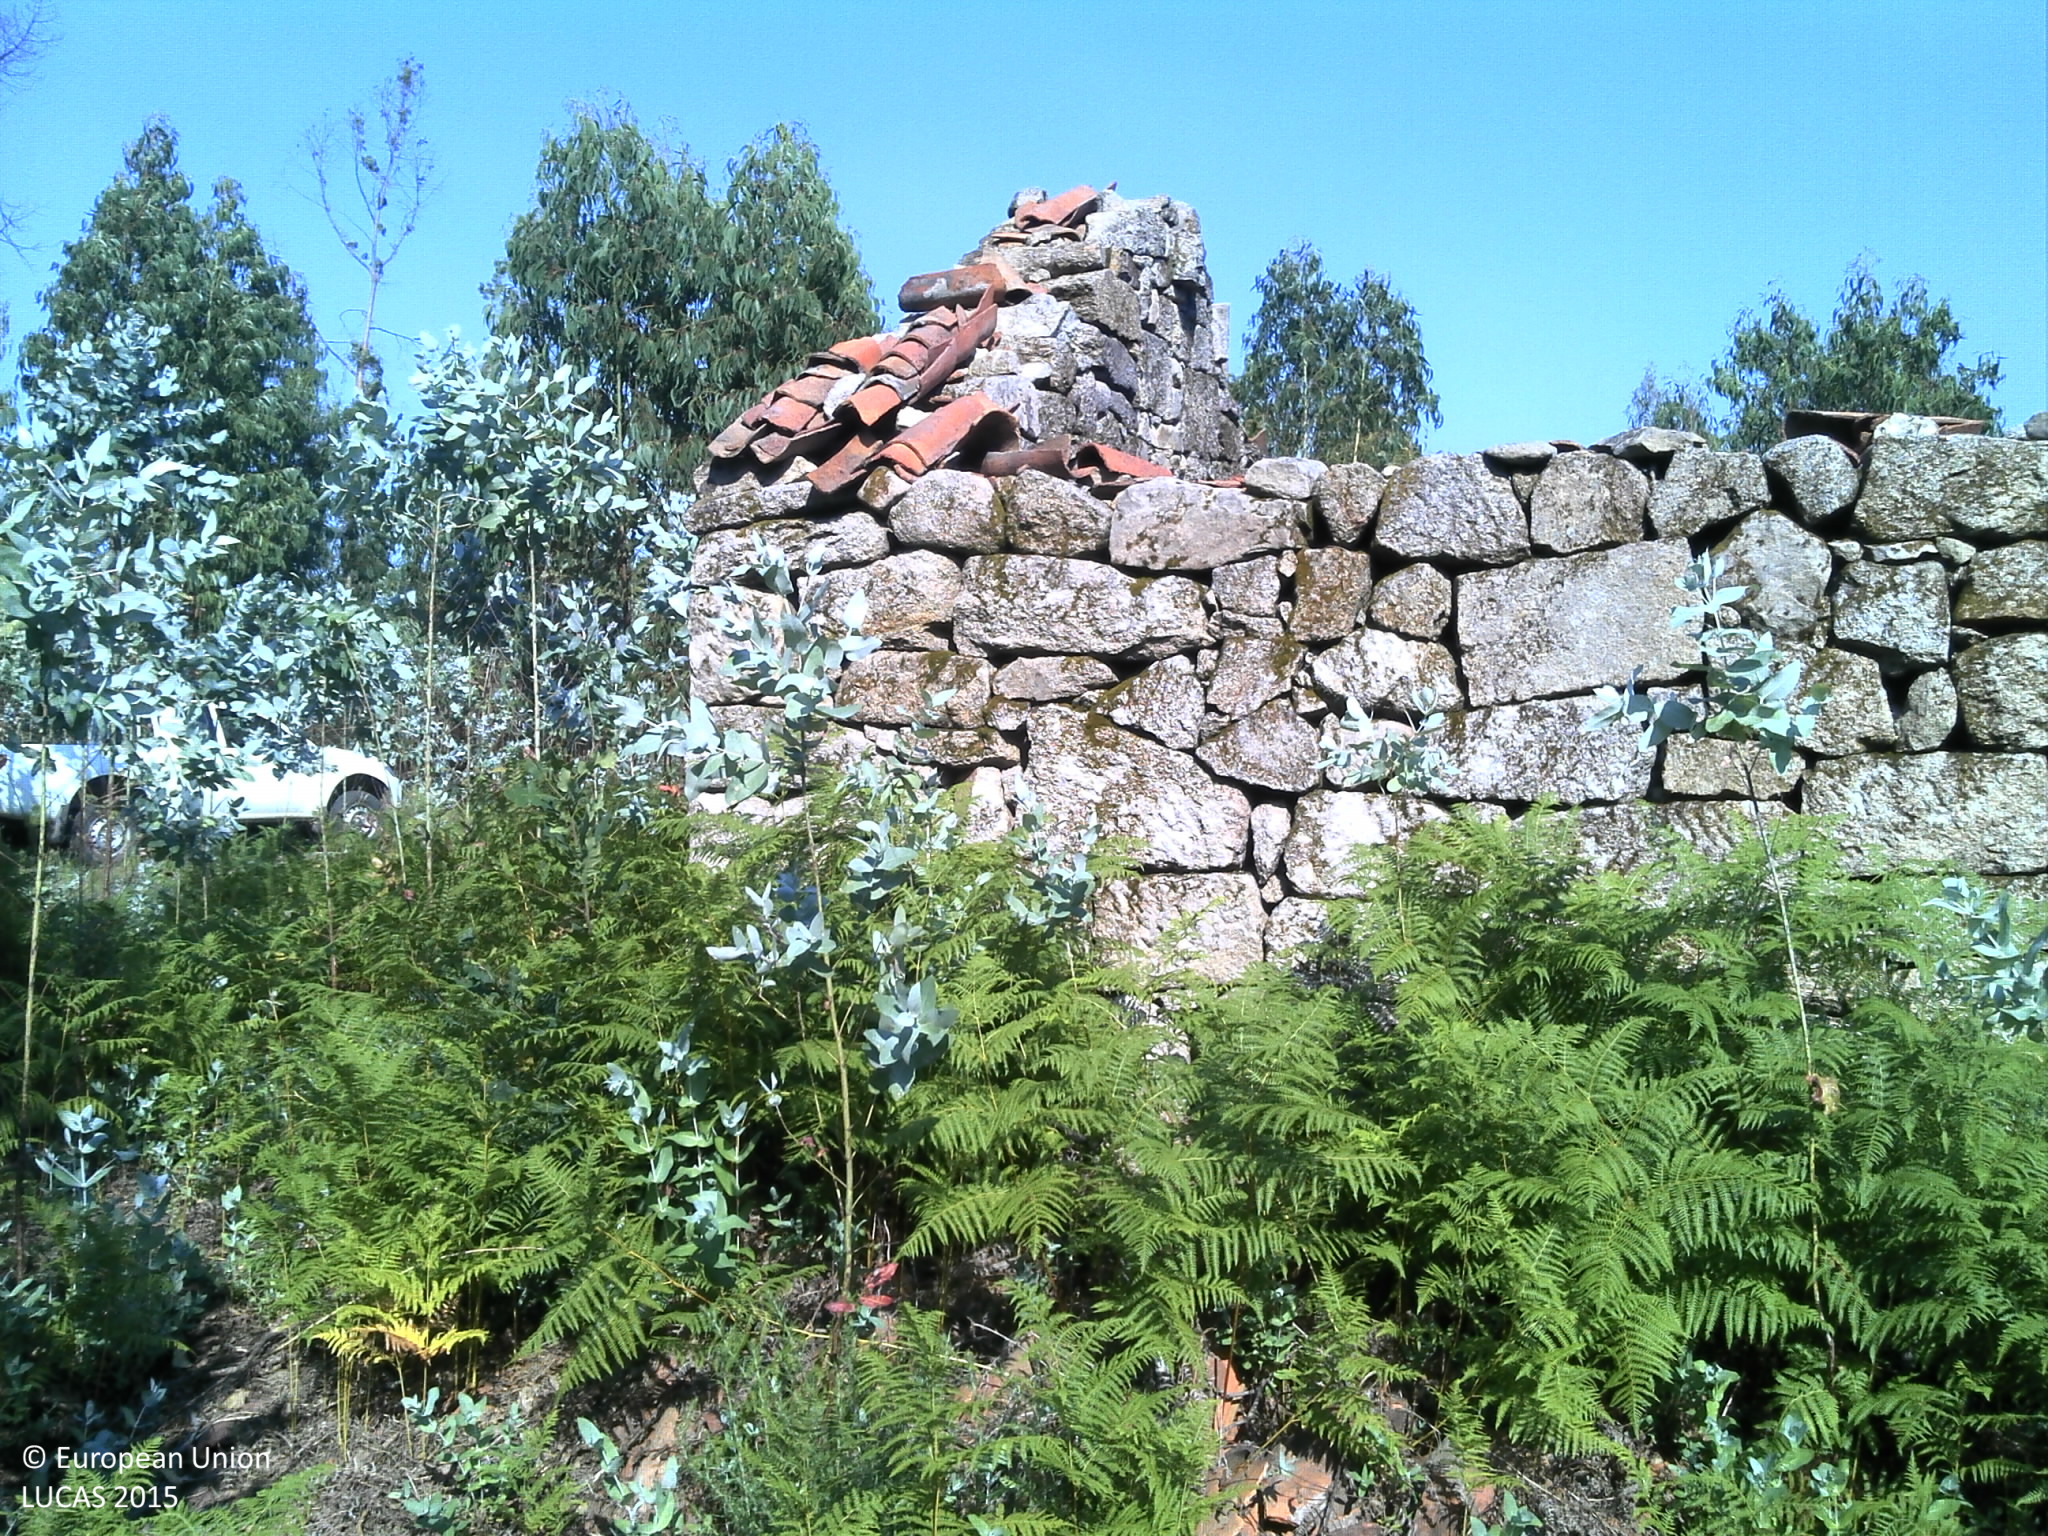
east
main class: Woodland
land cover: Broadleaved woodland
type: exotic forest
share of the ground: 50 - 75 %
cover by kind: broadleaved forest trees 60 %, shrubs 20 %, unconsolidated bare surface 20 %
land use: Forestry
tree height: < 5 m
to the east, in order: Broadleaved woodland; Tracks; Broadleaved woodland; Tracks; Broadleaved woodland; Tracks; Broadleaved woodland
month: June
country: PT
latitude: 40.6221
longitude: -8.0849
